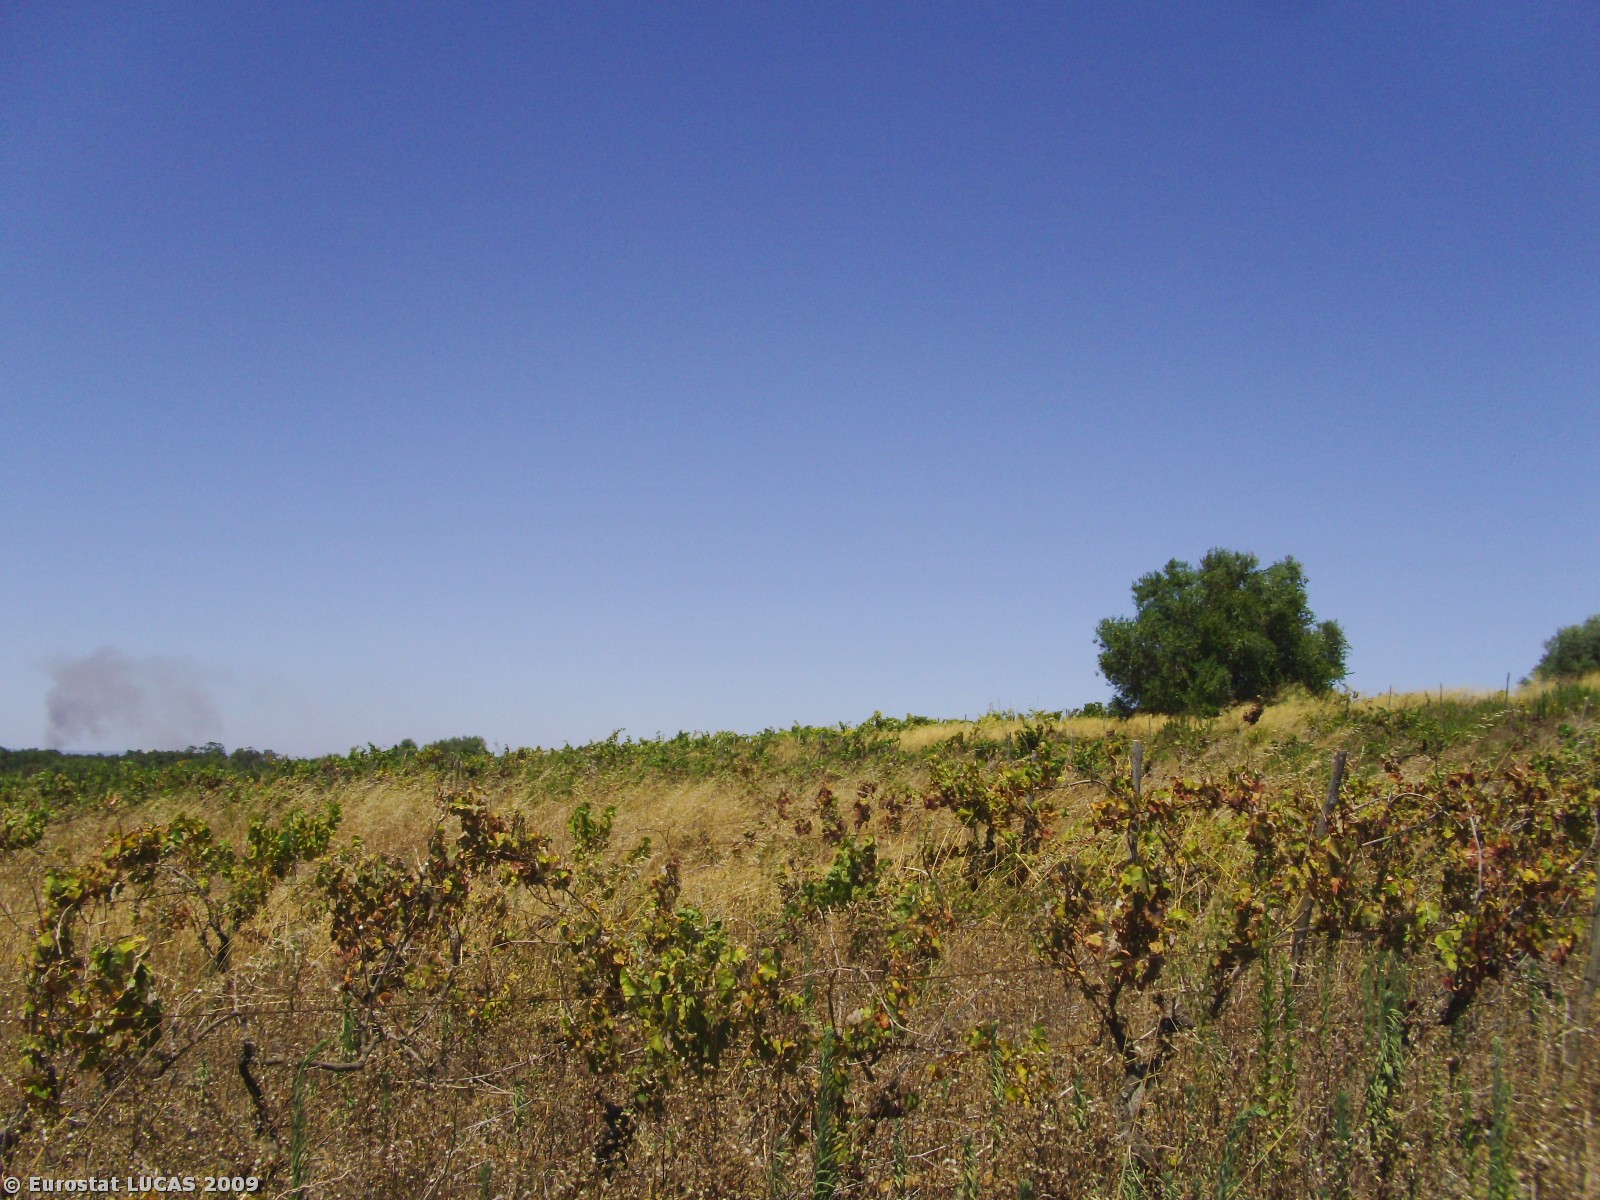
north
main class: Cropland
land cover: Vineyards
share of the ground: 25 - 50 %
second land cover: Spontaneously vegetated surfaces
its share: 25 - 50 %
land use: Fallow land
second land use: Unused
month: July
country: PT
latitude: 39.1254
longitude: -8.8485
